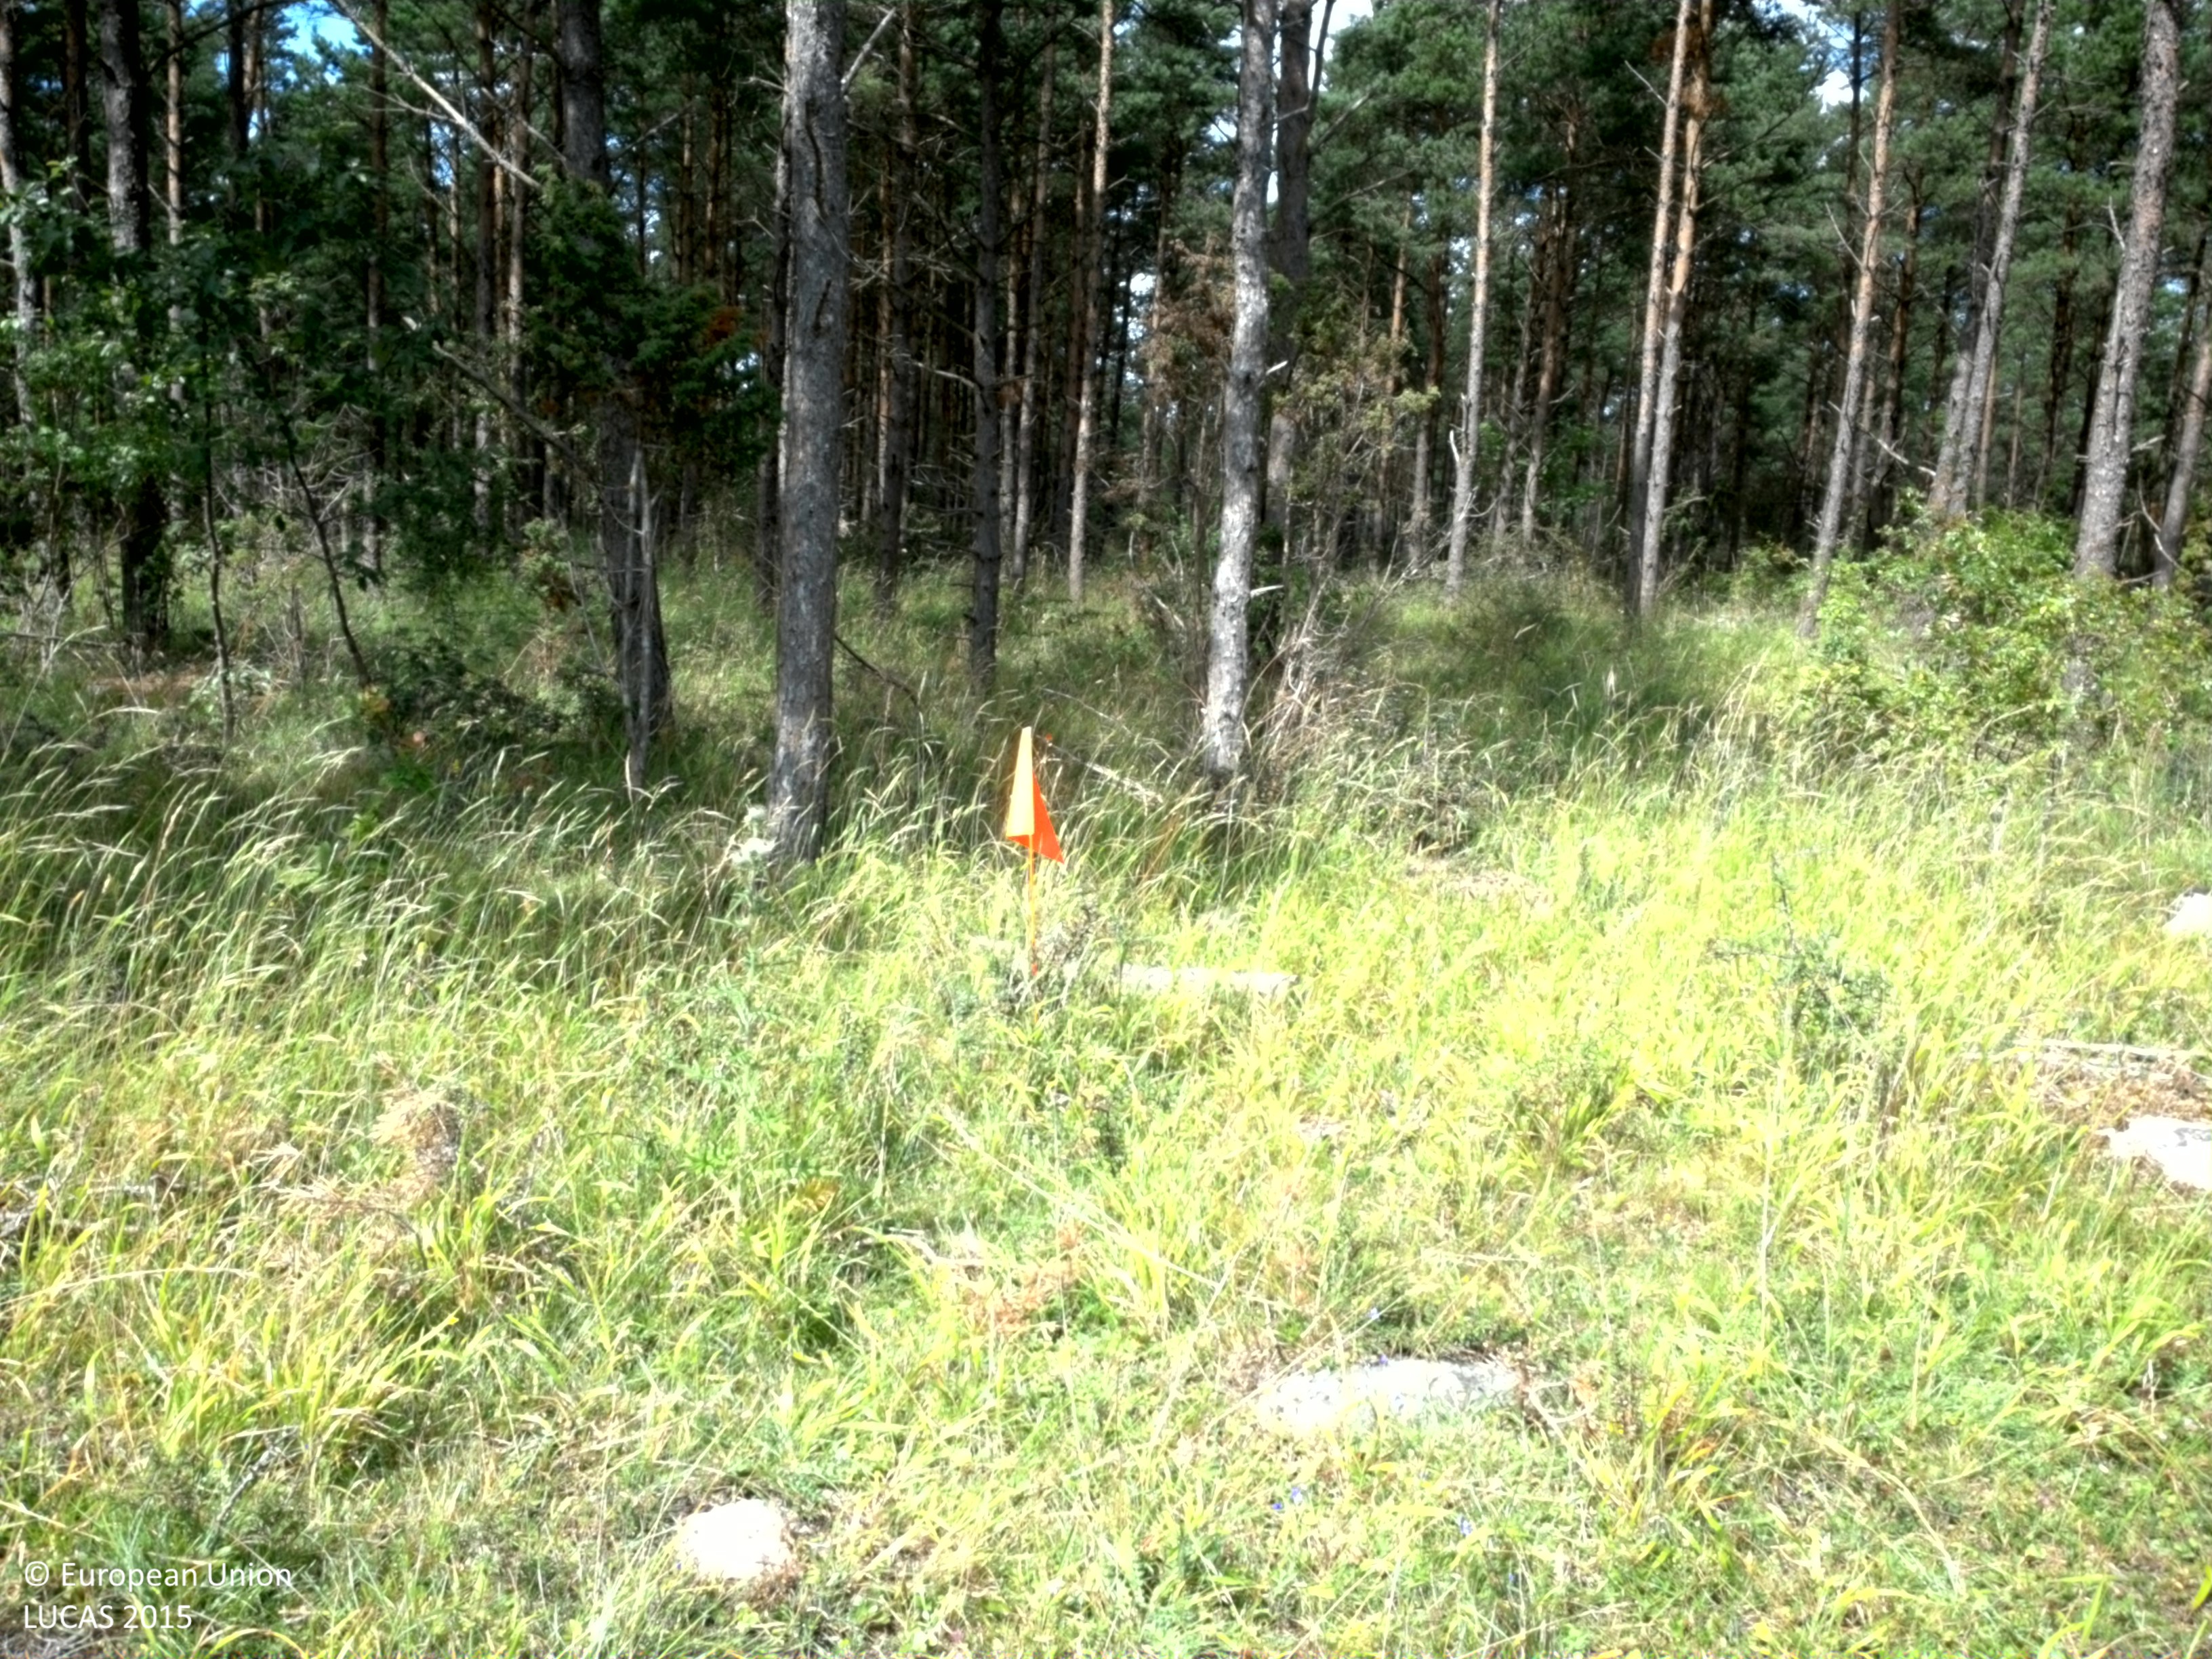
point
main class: Woodland
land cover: Pine dominated coniferous woodland
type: hemiboreal forest and nemoral coniferous forest and mixed broadleaved-coniferous forest
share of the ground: > 75 %
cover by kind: coniferous forest trees 75 %, herbaceous plants 15 %, shrubs 10 %
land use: Forestry
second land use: Agriculture (excluding fallow land and kitchen gardens)
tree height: > 5 m
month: July
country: SE
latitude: 57.1553
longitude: 18.1911
